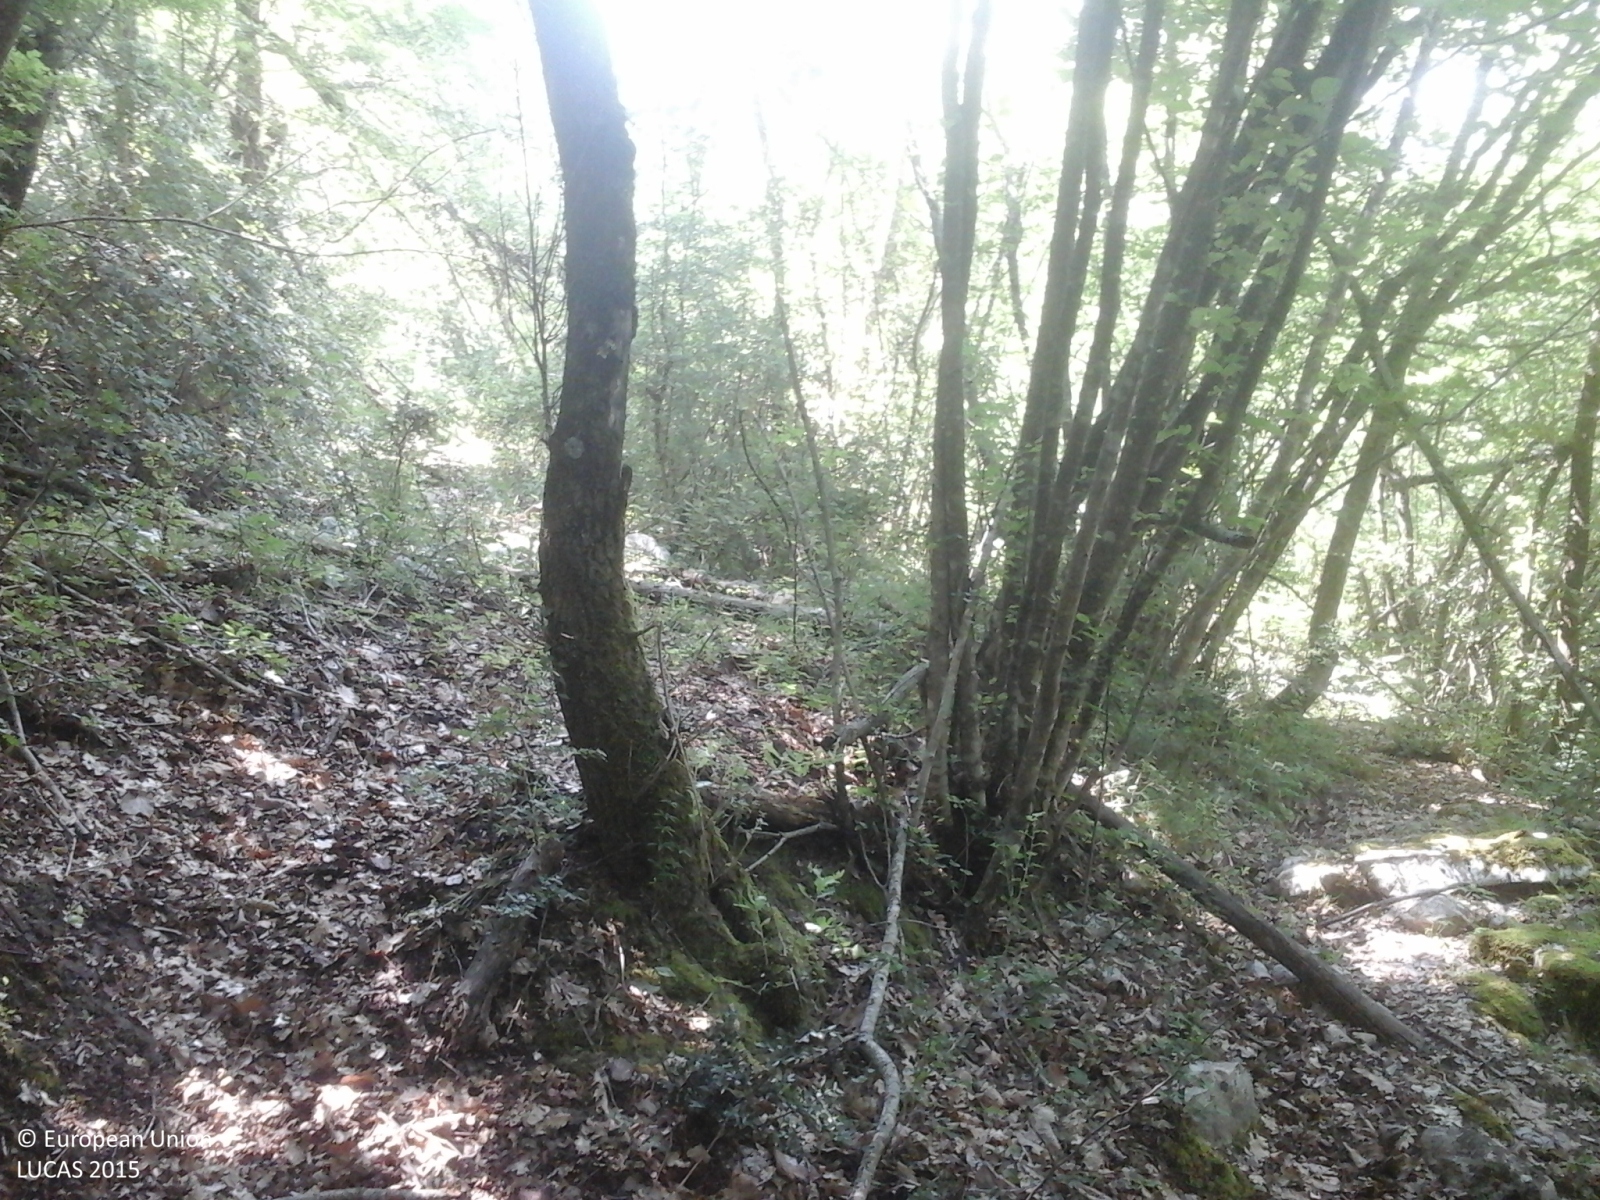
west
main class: Woodland
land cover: Broadleaved woodland
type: thermophilous deciduous forest
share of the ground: > 75 %
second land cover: Grassland without tree/shrub cover
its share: > 75 %
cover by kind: broadleaved forest trees 95 %, herbaceous plants 5 %
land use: Forestry
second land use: Agriculture (excluding fallow land and kitchen gardens)
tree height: > 5 m
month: June
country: IT
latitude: 41.5543
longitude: 13.2127
